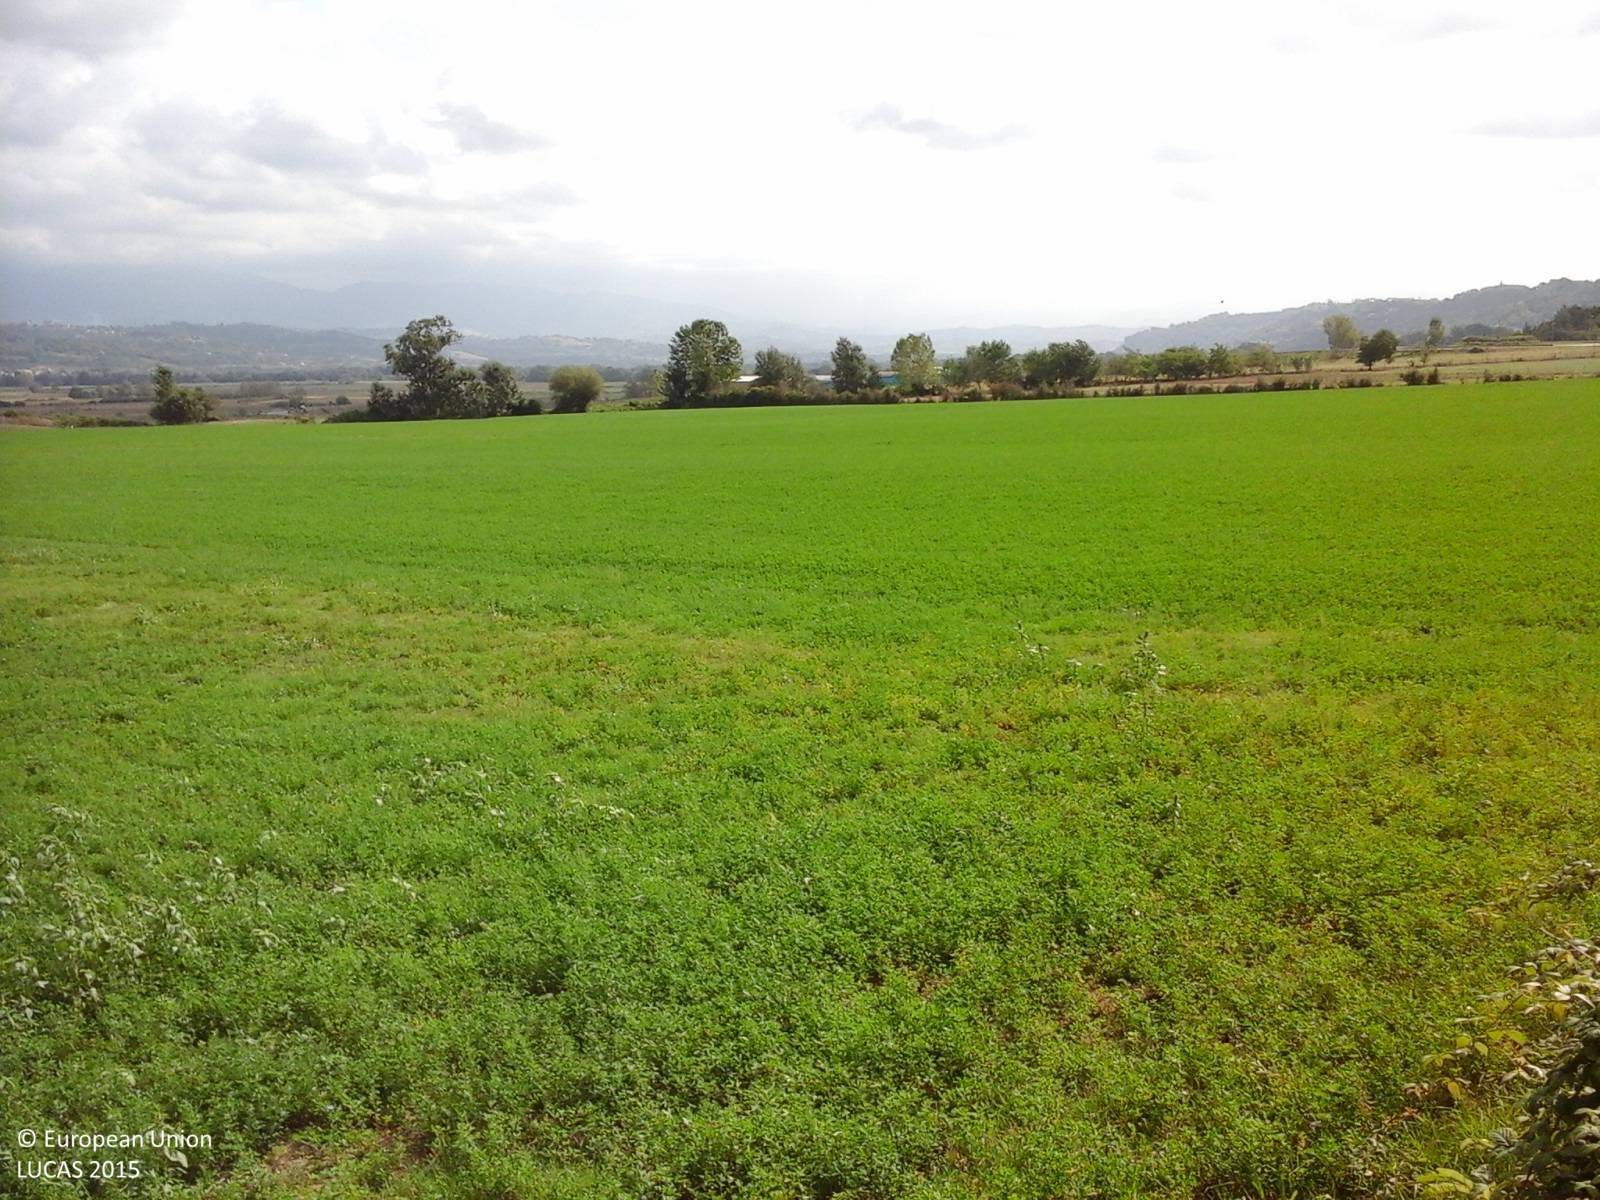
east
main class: Cropland
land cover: Lucerne
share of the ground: > 75 %
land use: Agriculture (excluding fallow land and kitchen gardens)
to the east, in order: Lucerne; Shrubland with sparse tree cover; Grassland without tree/shrub cover; Tracks; Grassland without tree/shrub cover; Fences; Paved roads, cycling and walking lanes
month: September
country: IT
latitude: 42.2792
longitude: 12.5256
